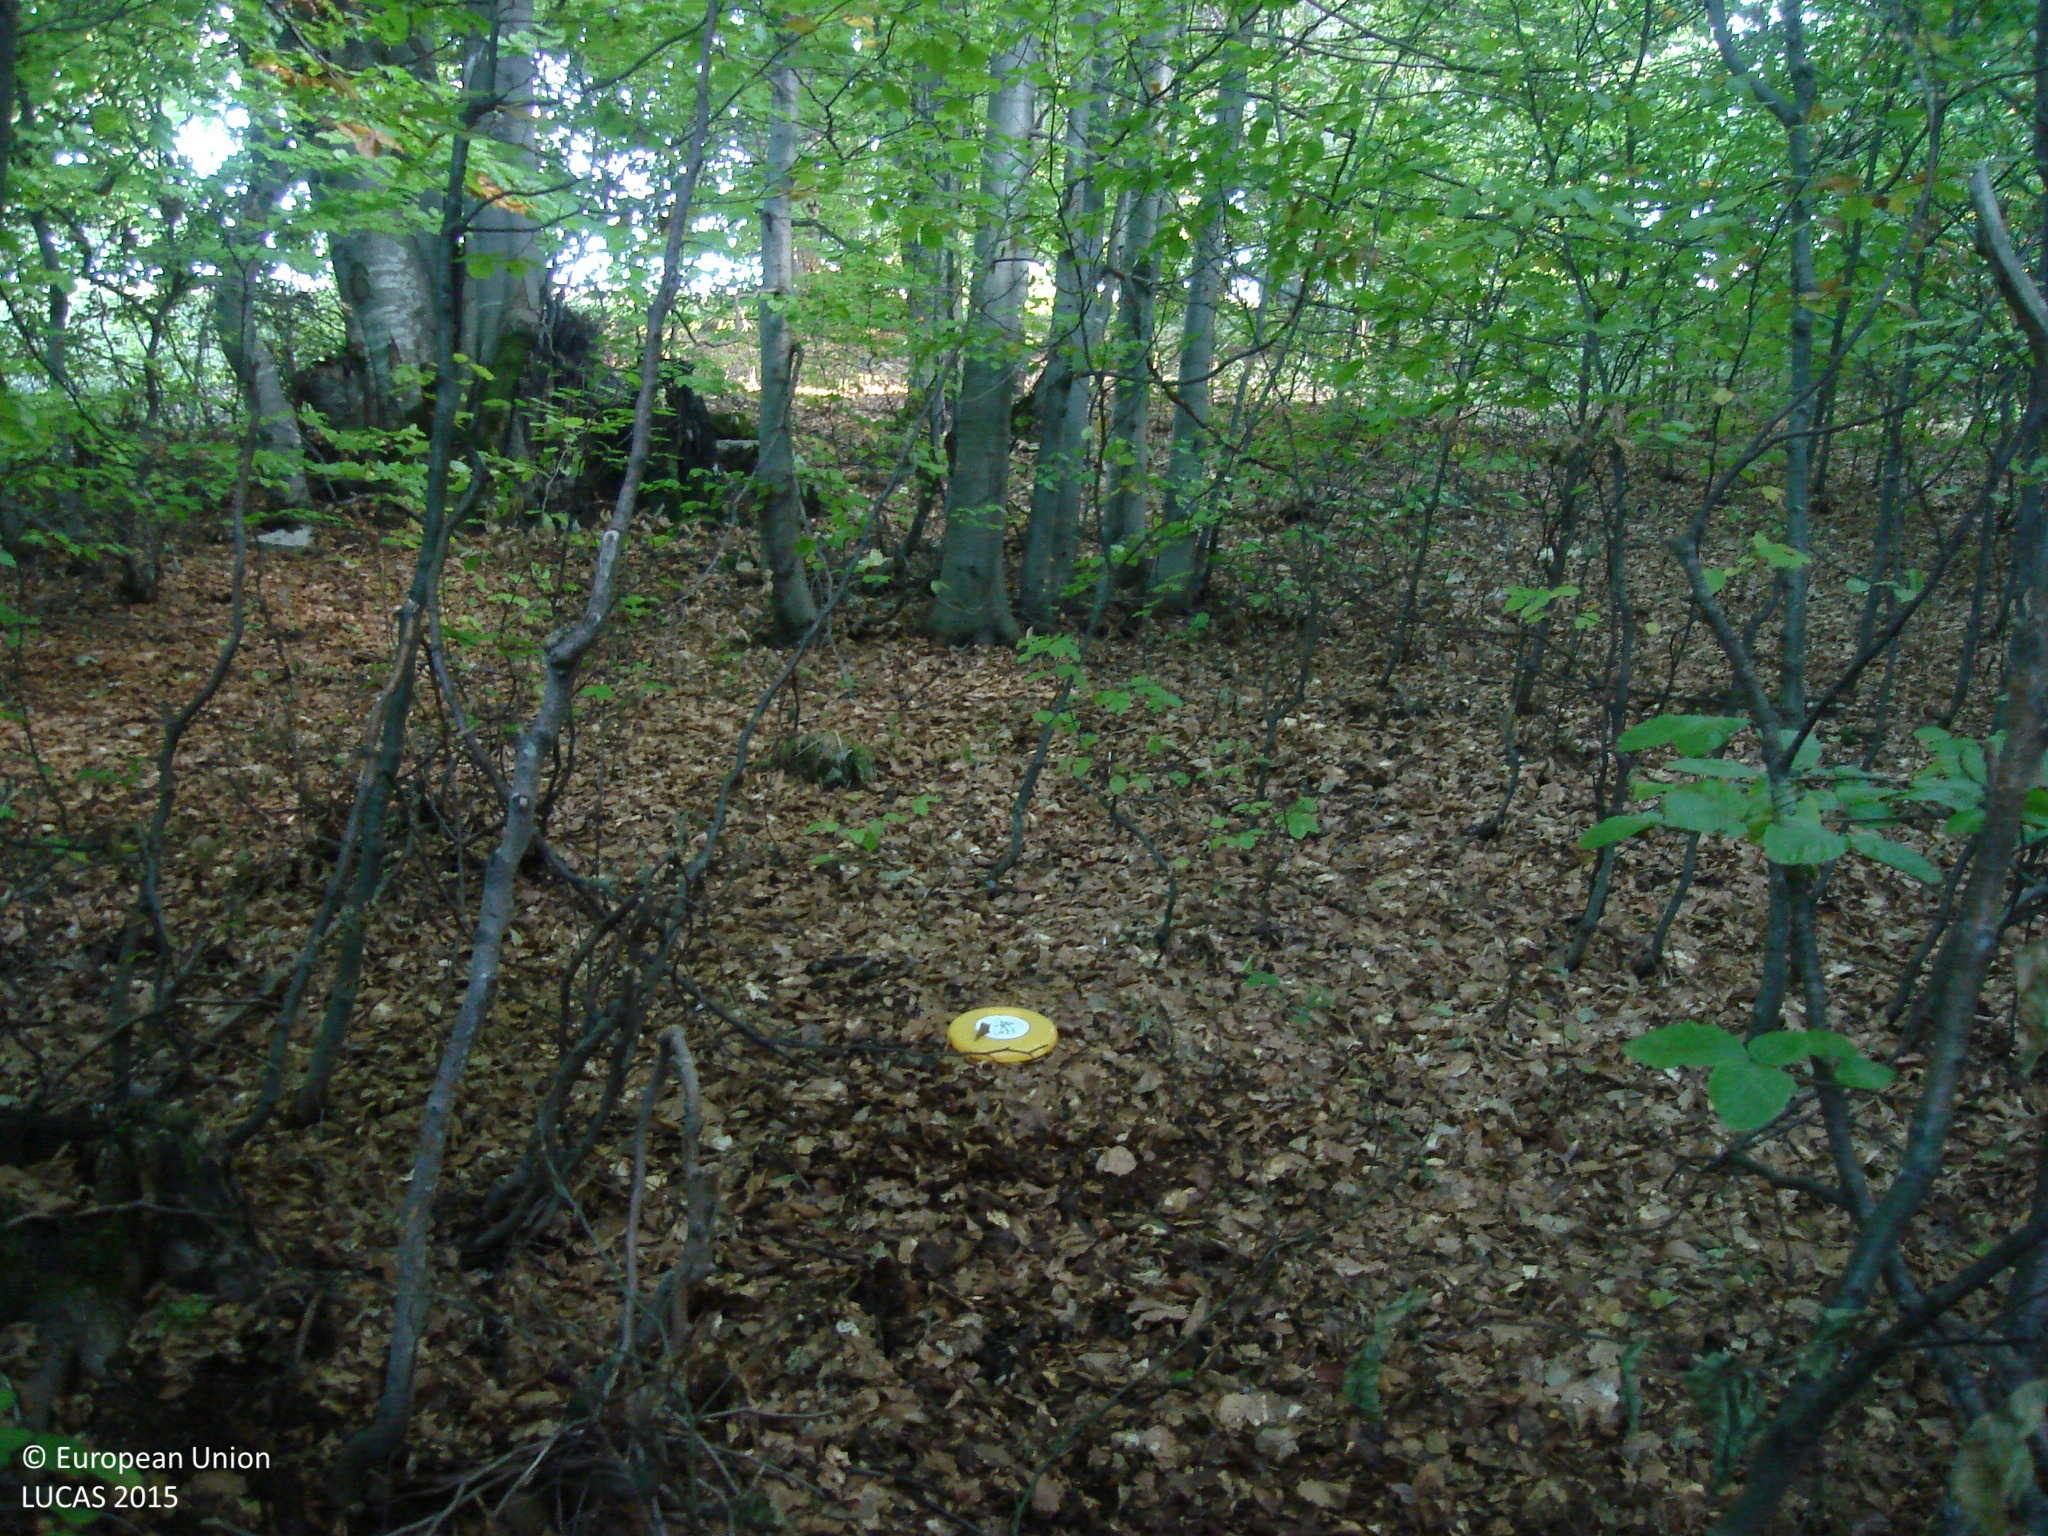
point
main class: Woodland
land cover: Broadleaved woodland
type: beech forest
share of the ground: > 75 %
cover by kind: broadleaved forest trees 85 %, consolidated bare surface 10 %, lichens and mosses 5 %
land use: Forestry
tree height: > 5 m
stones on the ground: < 10 %
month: October
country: BG
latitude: 43.1442
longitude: 23.4300
